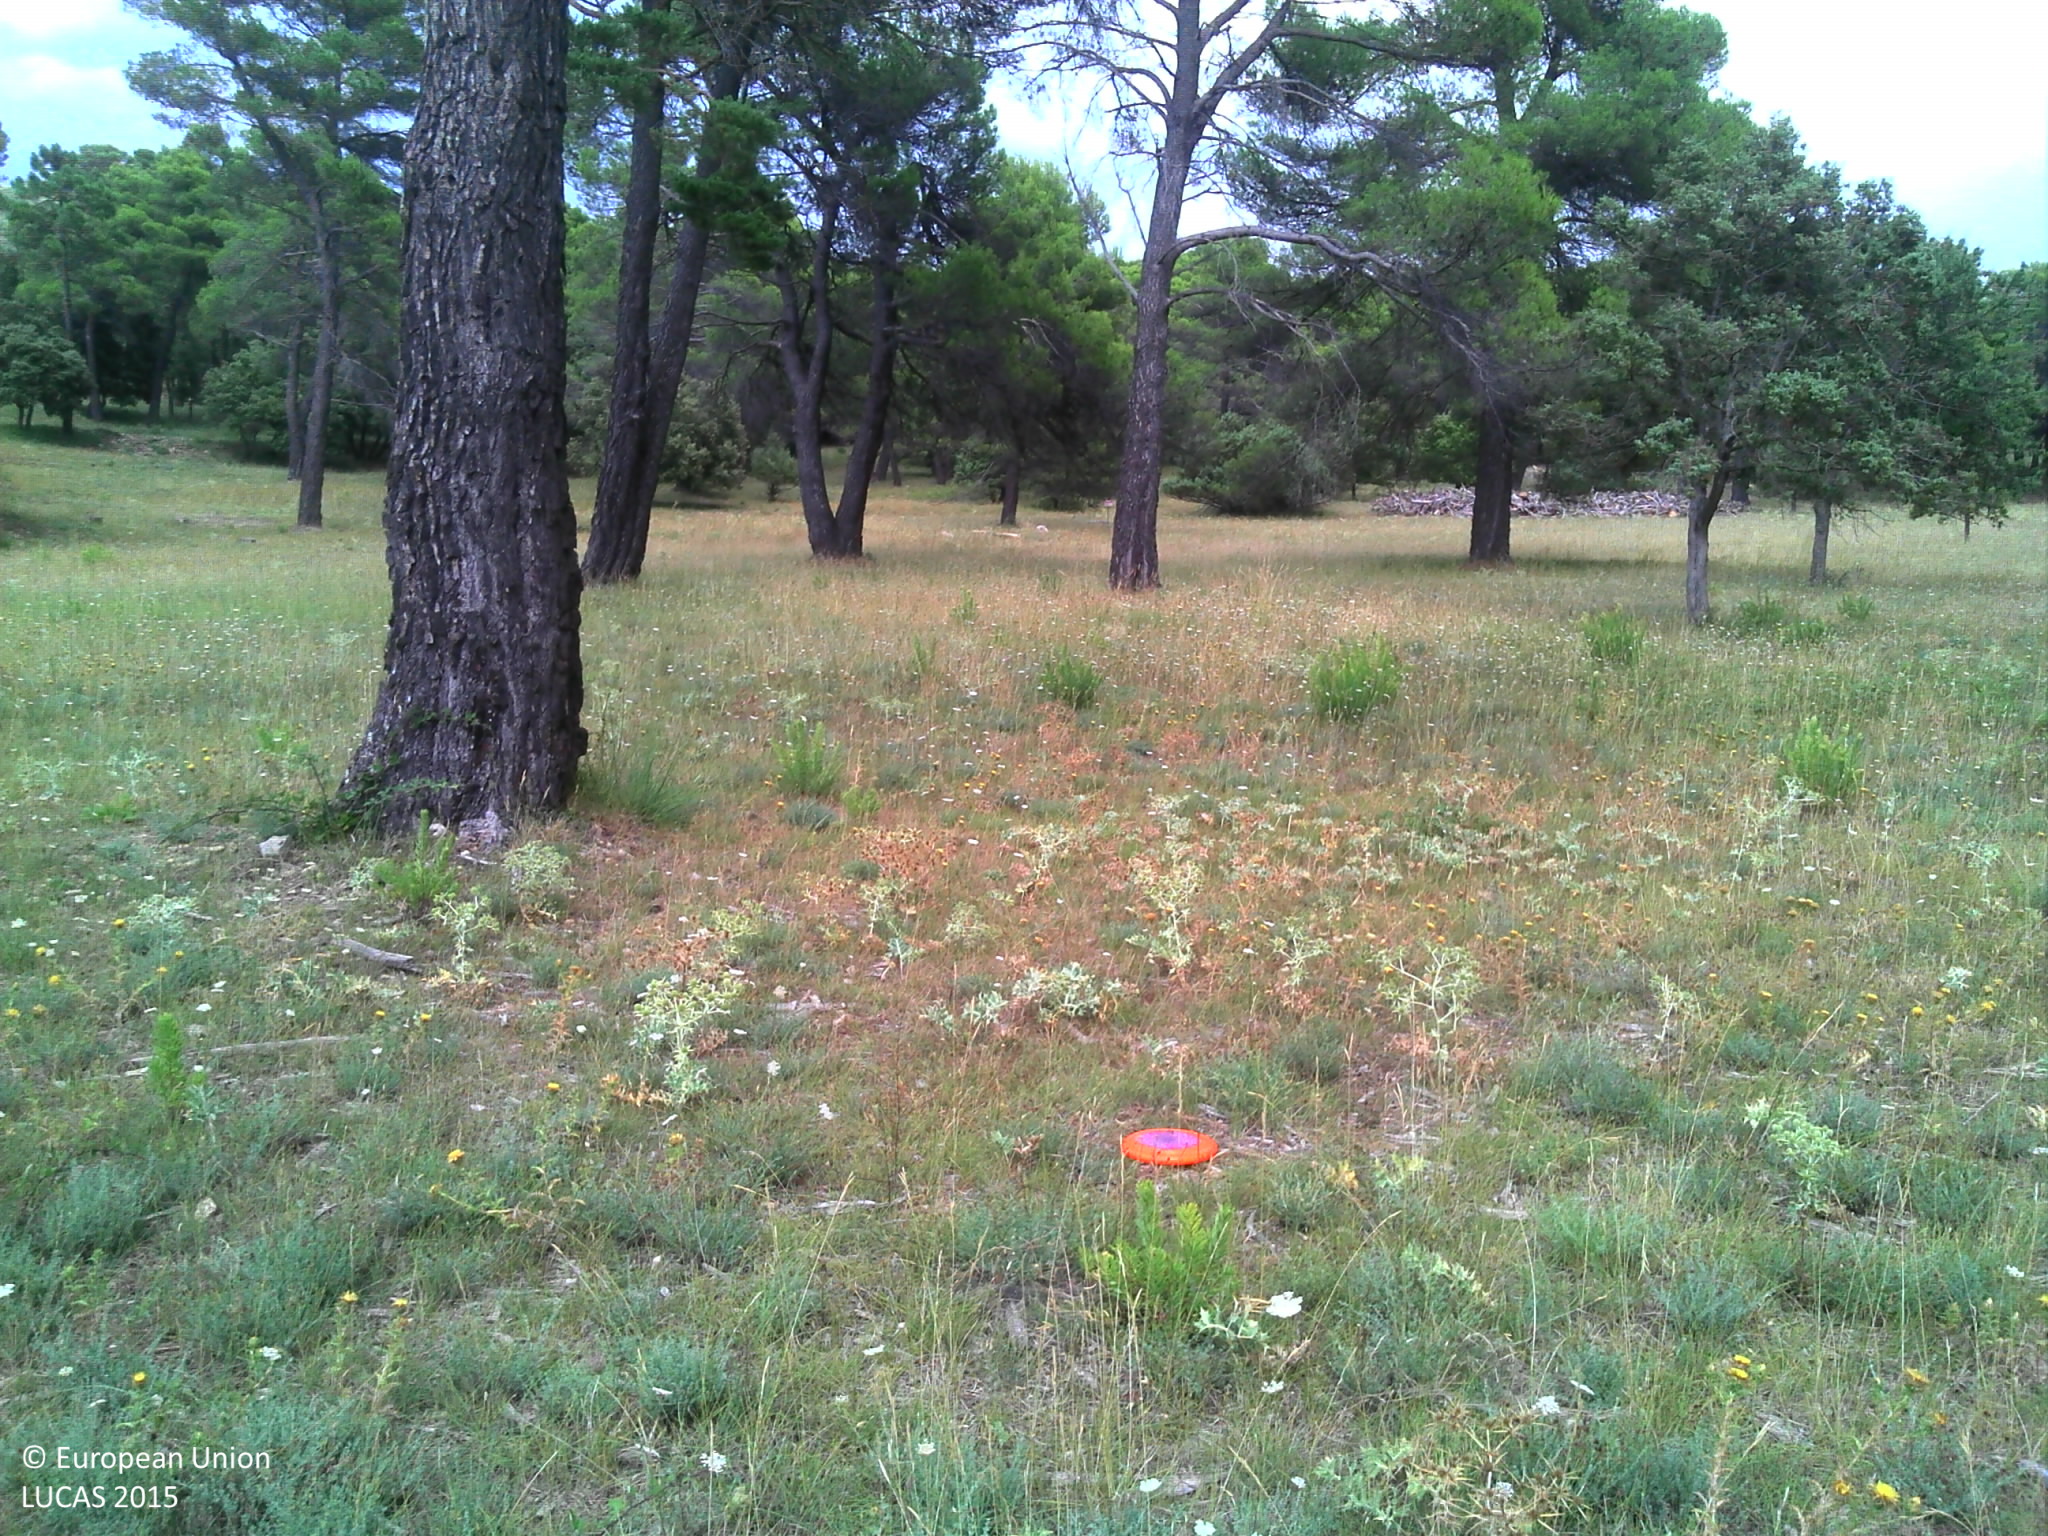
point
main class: Grassland
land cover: Grassland with sparse tree/shrub cover
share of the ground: > 75 %
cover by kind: herbaceous plants 95 %, coniferous forest trees 5 %
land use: Amenities, museums, leisure
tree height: > 5 m
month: August
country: FR
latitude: 43.5814
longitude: 6.3305
